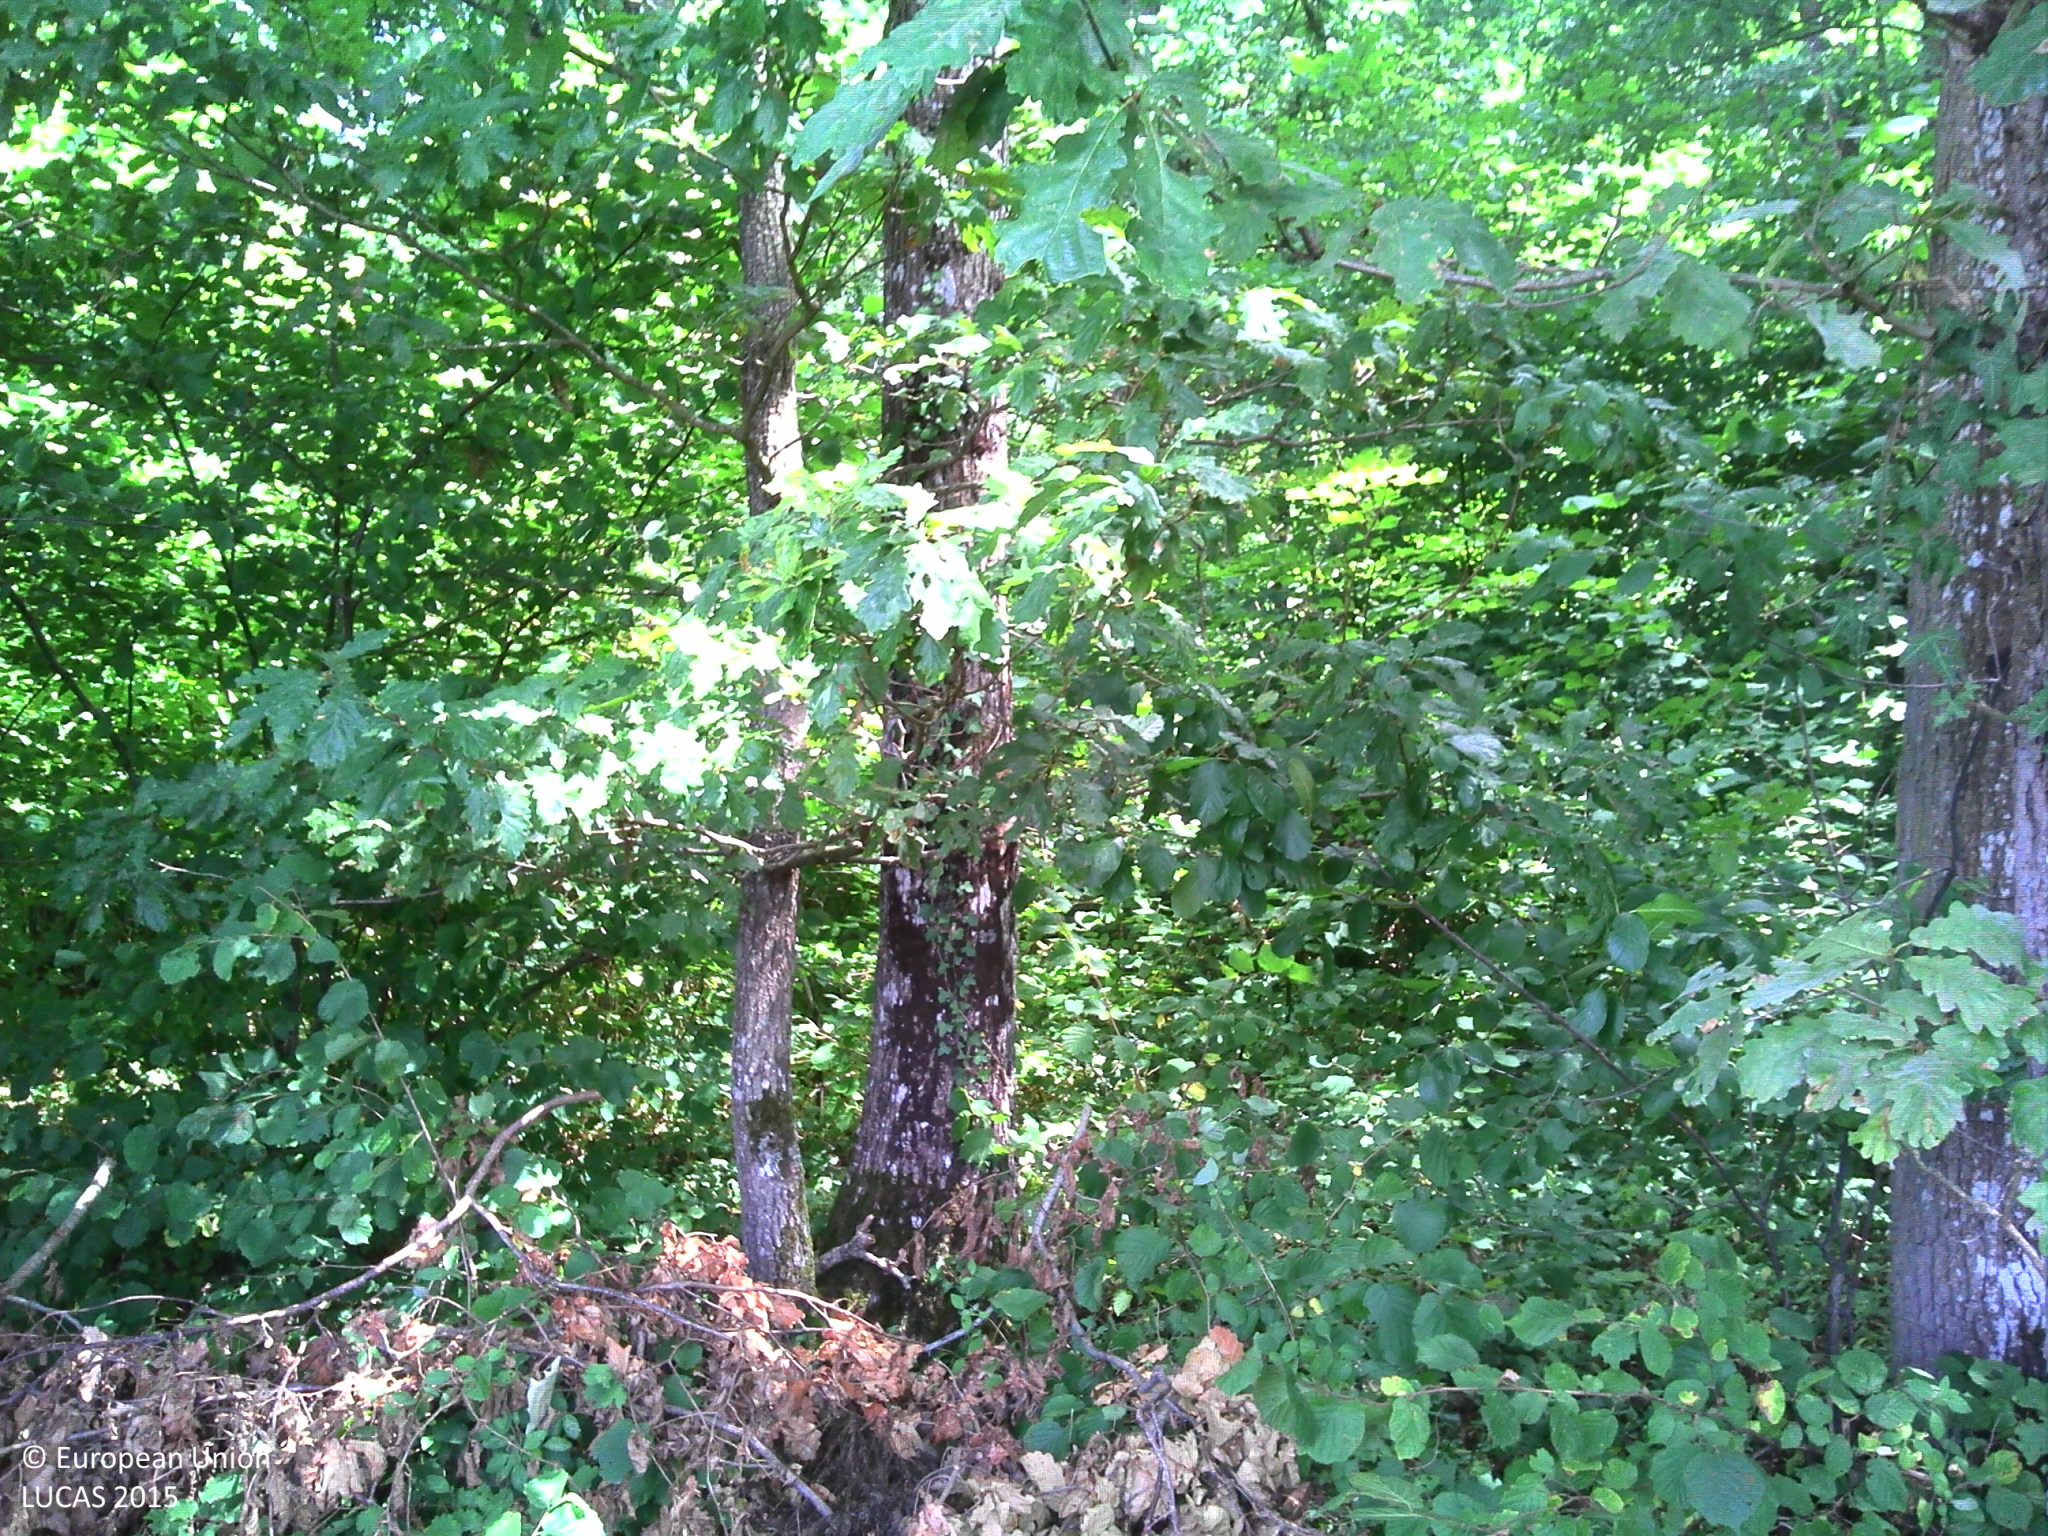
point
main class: Woodland
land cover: Broadleaved woodland
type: acidophilous oak and oak-birch forest
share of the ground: > 75 %
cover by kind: broadleaved forest trees 50 %, shrubs 30 %, herbaceous plants 20 %
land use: Forestry
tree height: > 5 m
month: July
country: FR
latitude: 48.0542
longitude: 0.5721
